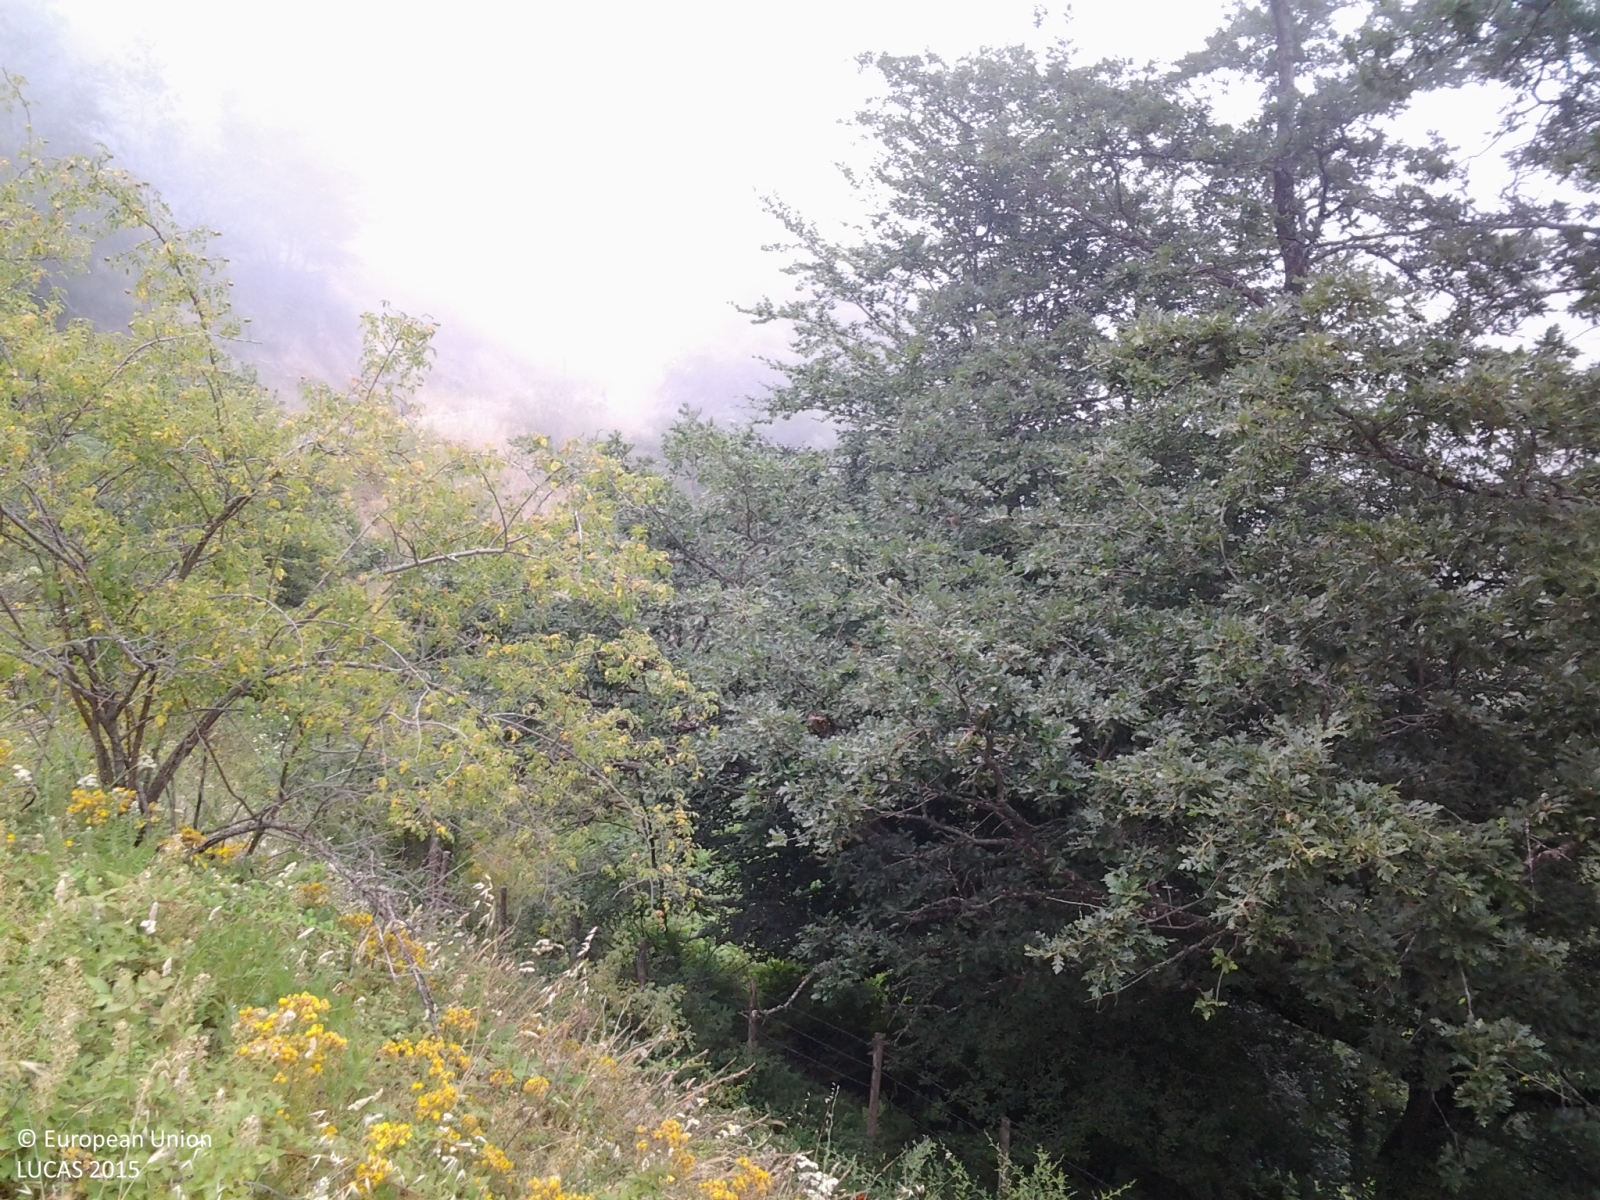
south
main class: Woodland
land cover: Broadleaved woodland
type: thermophilous deciduous forest
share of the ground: > 75 %
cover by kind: broadleaved forest trees 90 %, shrubs 5 %, herbaceous plants 5 %
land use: Amenities, museums, leisure
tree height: > 5 m
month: July
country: IT
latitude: 37.9861
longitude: 14.8745
